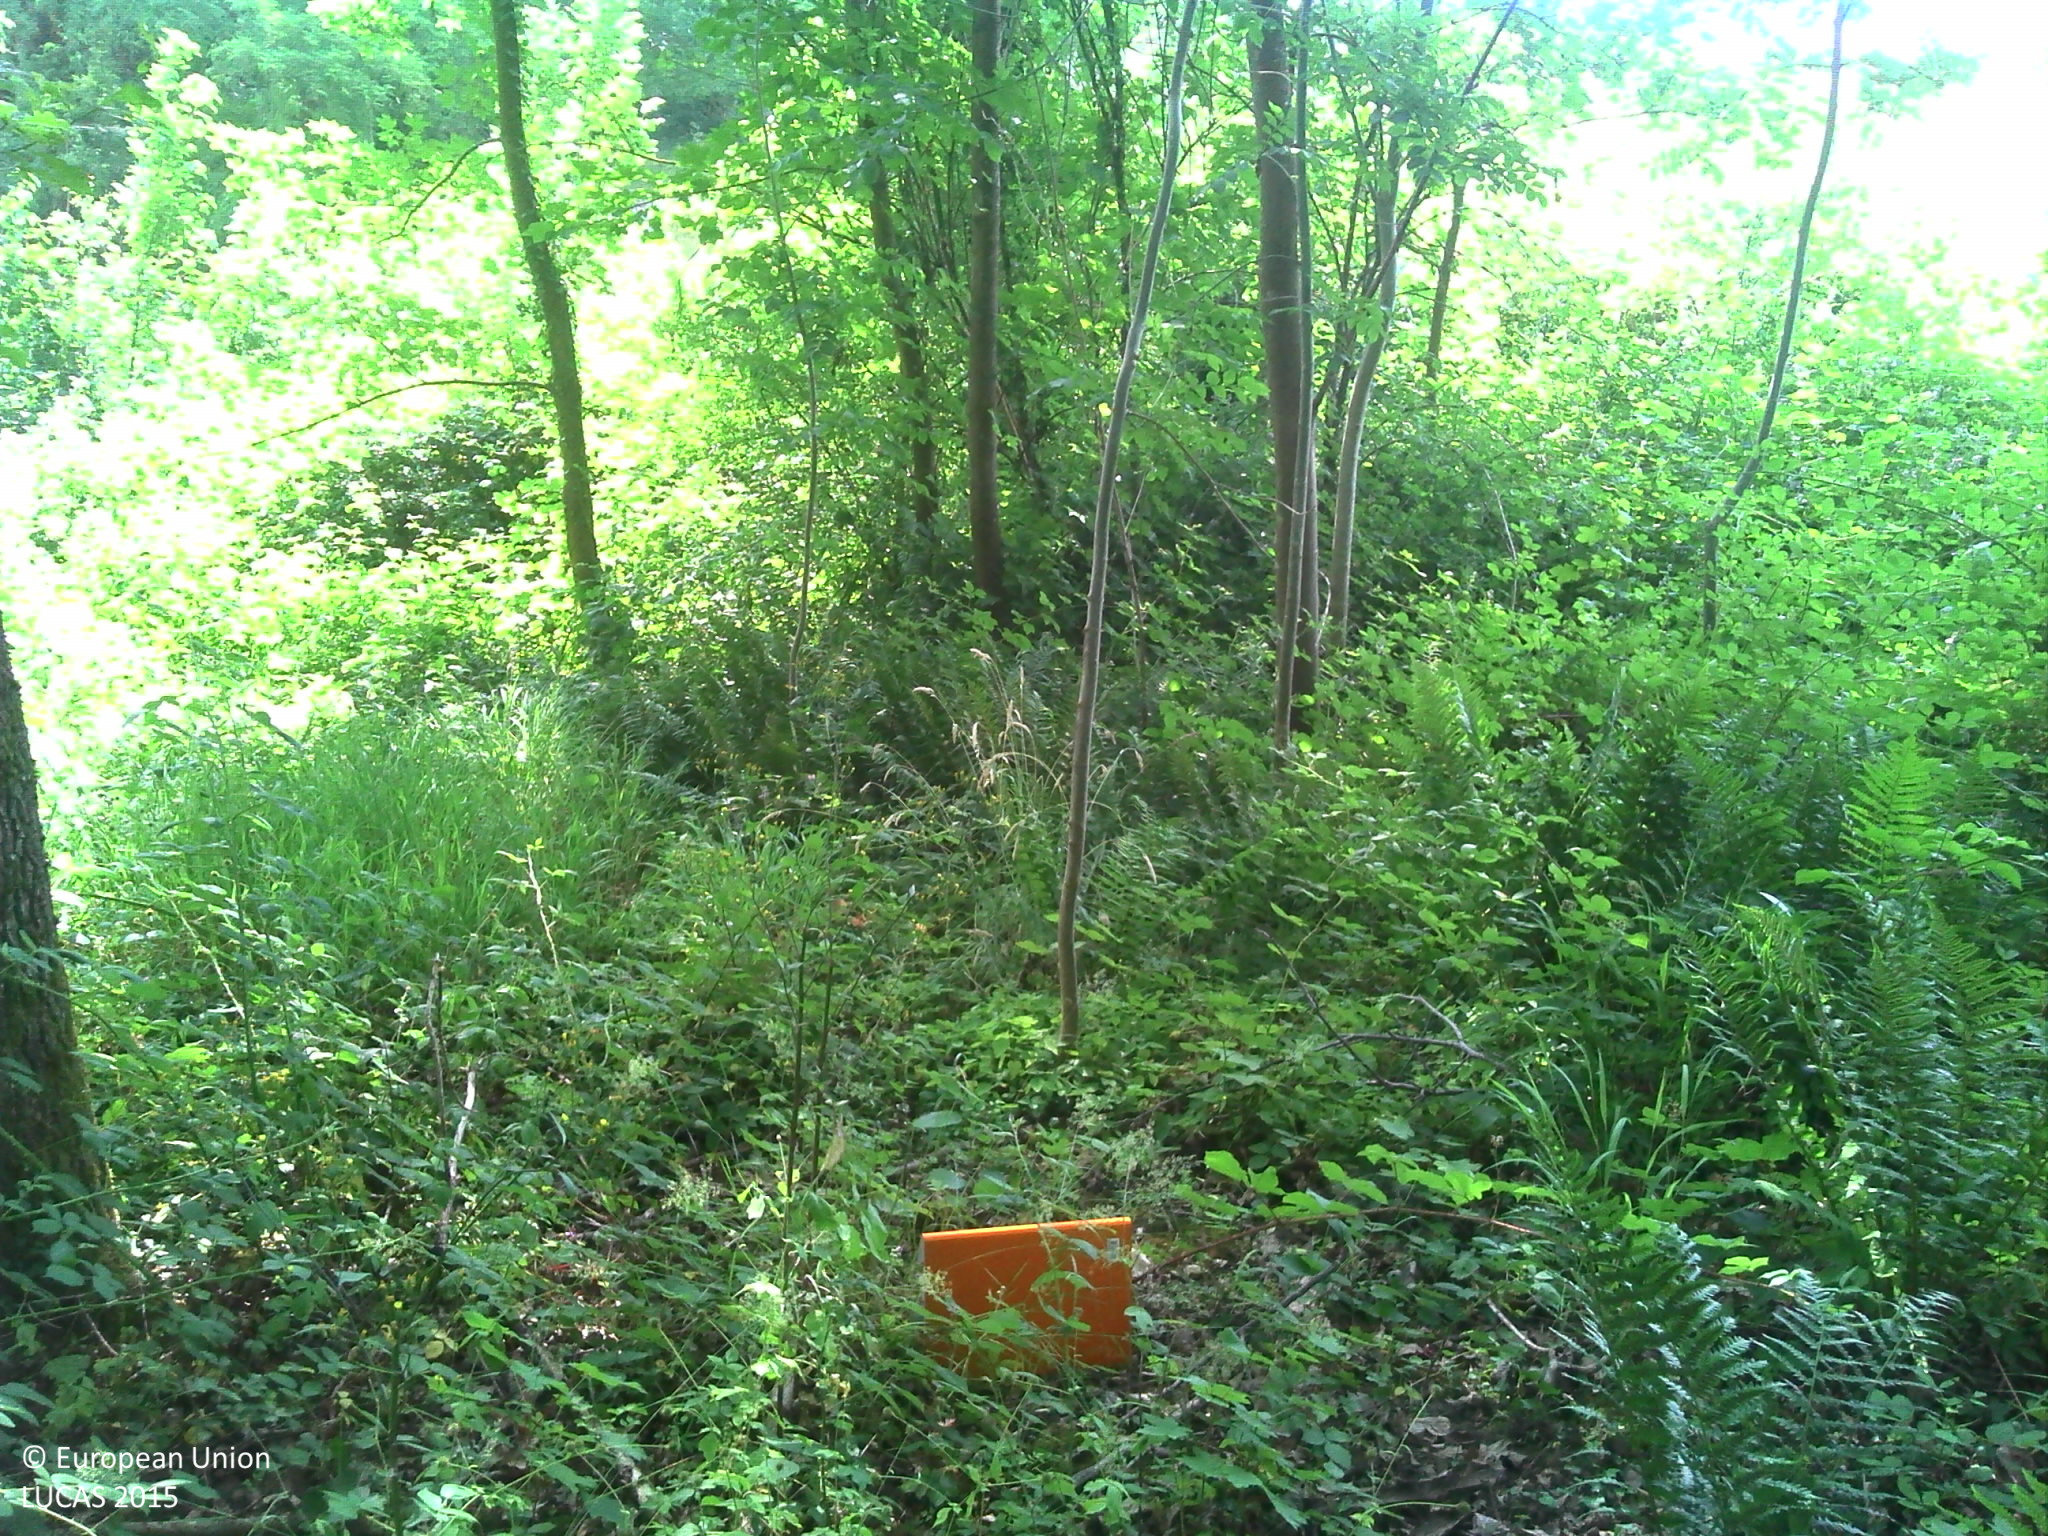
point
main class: Woodland
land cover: Broadleaved woodland
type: mesophytic deciduous forest
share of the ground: > 75 %
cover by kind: broadleaved forest trees 80 %, shrubs 10 %, herbaceous plants 10 %
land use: Forestry
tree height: > 5 m
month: July
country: FR
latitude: 49.1057
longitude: 3.3490
